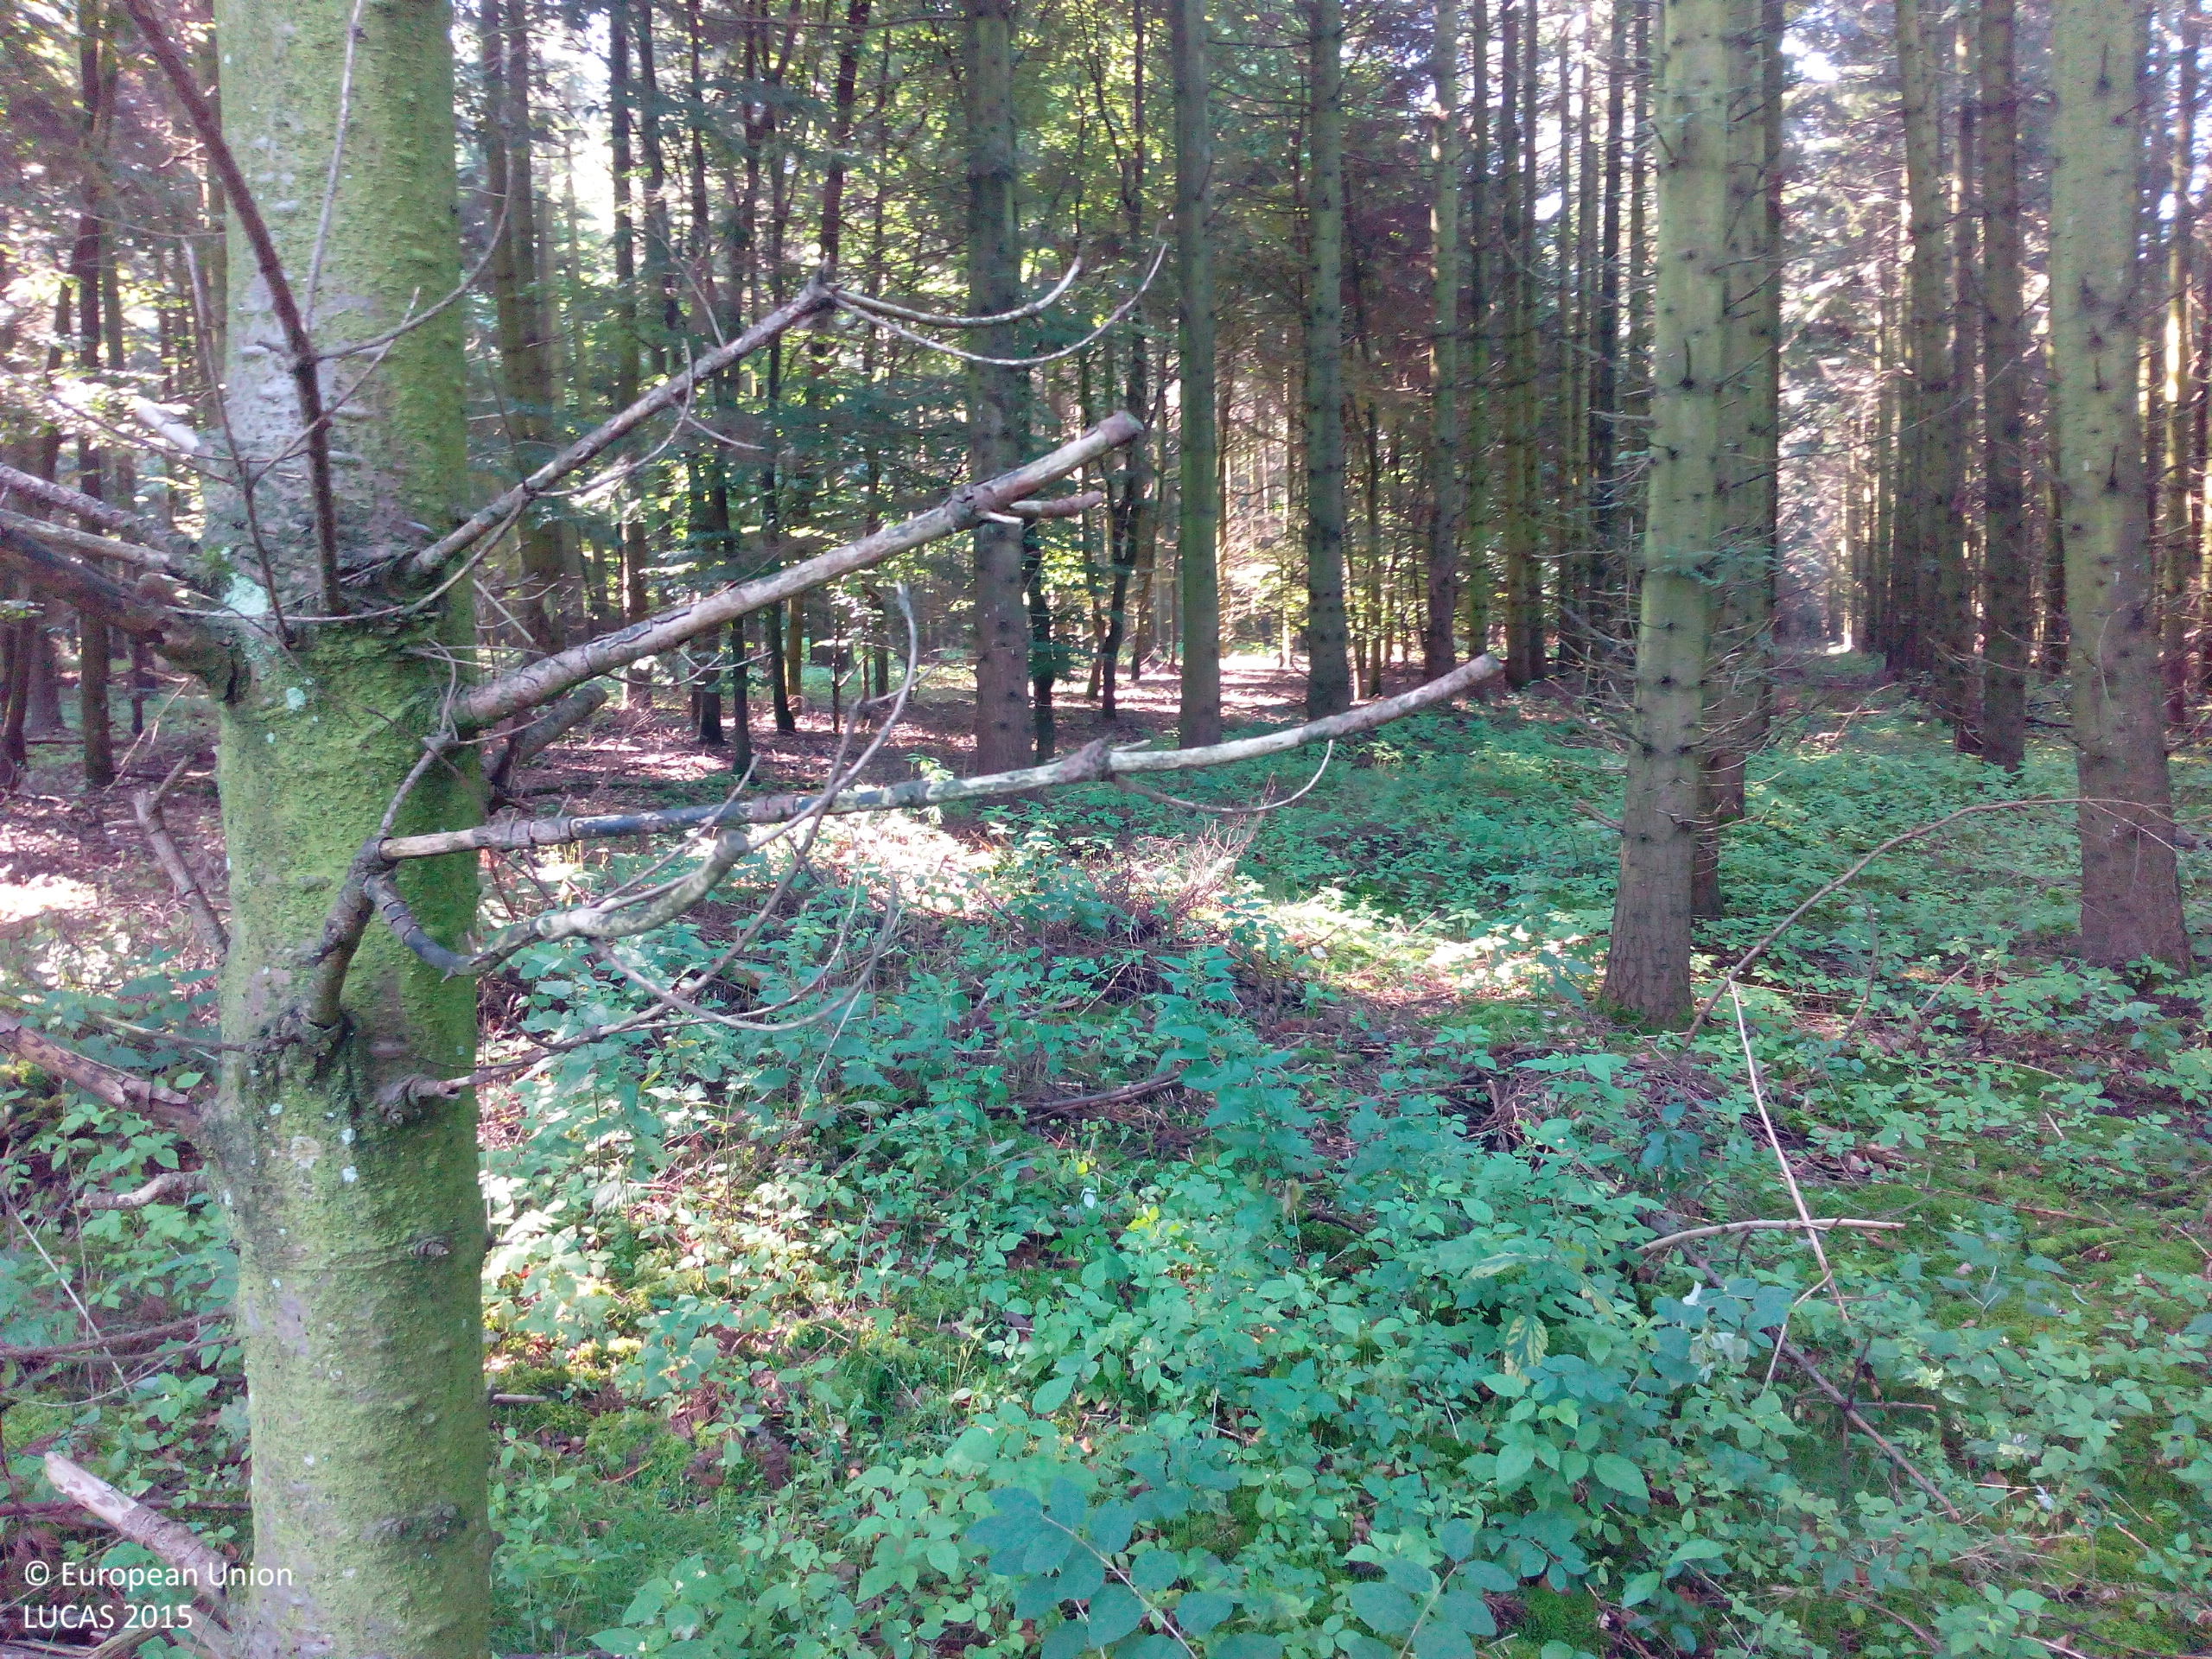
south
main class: Woodland
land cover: Other mixed woodland
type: hemiboreal forest and nemoral coniferous forest and mixed broadleaved-coniferous forest
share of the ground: > 75 %
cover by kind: coniferous forest trees 75 %, broadleaved forest trees 25 %
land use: Forestry
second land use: Amenities, museums, leisure
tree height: > 5 m
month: August
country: DE
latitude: 53.8152
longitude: 9.8330
